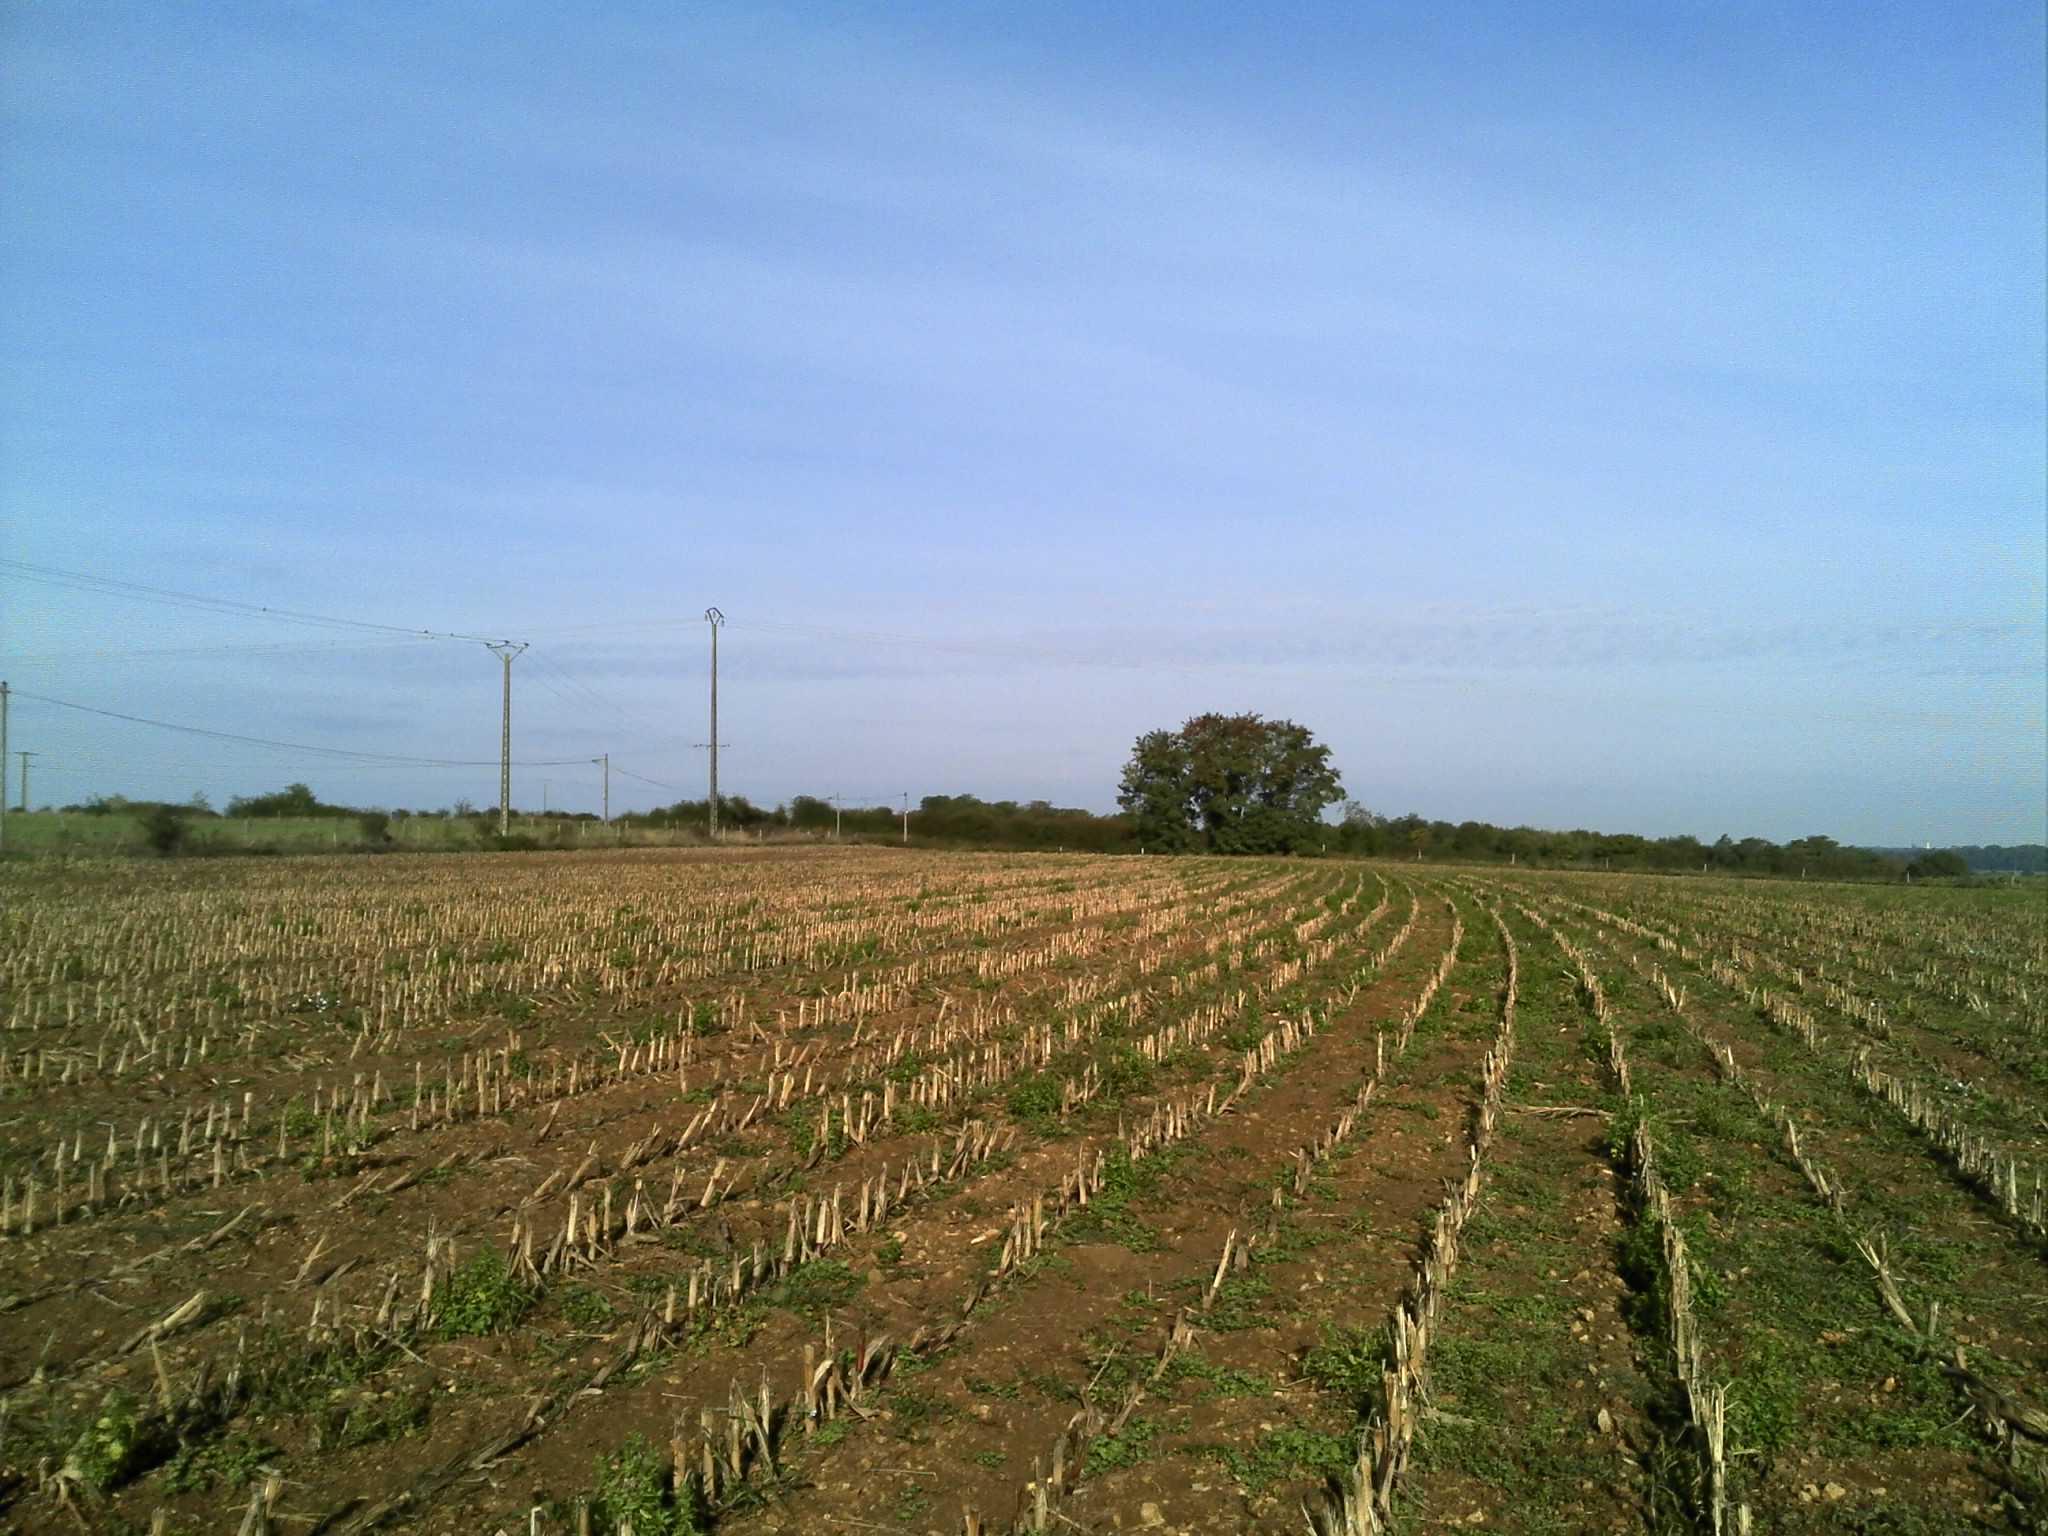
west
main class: Cropland
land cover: Maize
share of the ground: < 10 %
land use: Agriculture (excluding fallow land and kitchen gardens)
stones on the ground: 10 - 25 %
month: September
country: FR
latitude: 48.0898
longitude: 0.5654
